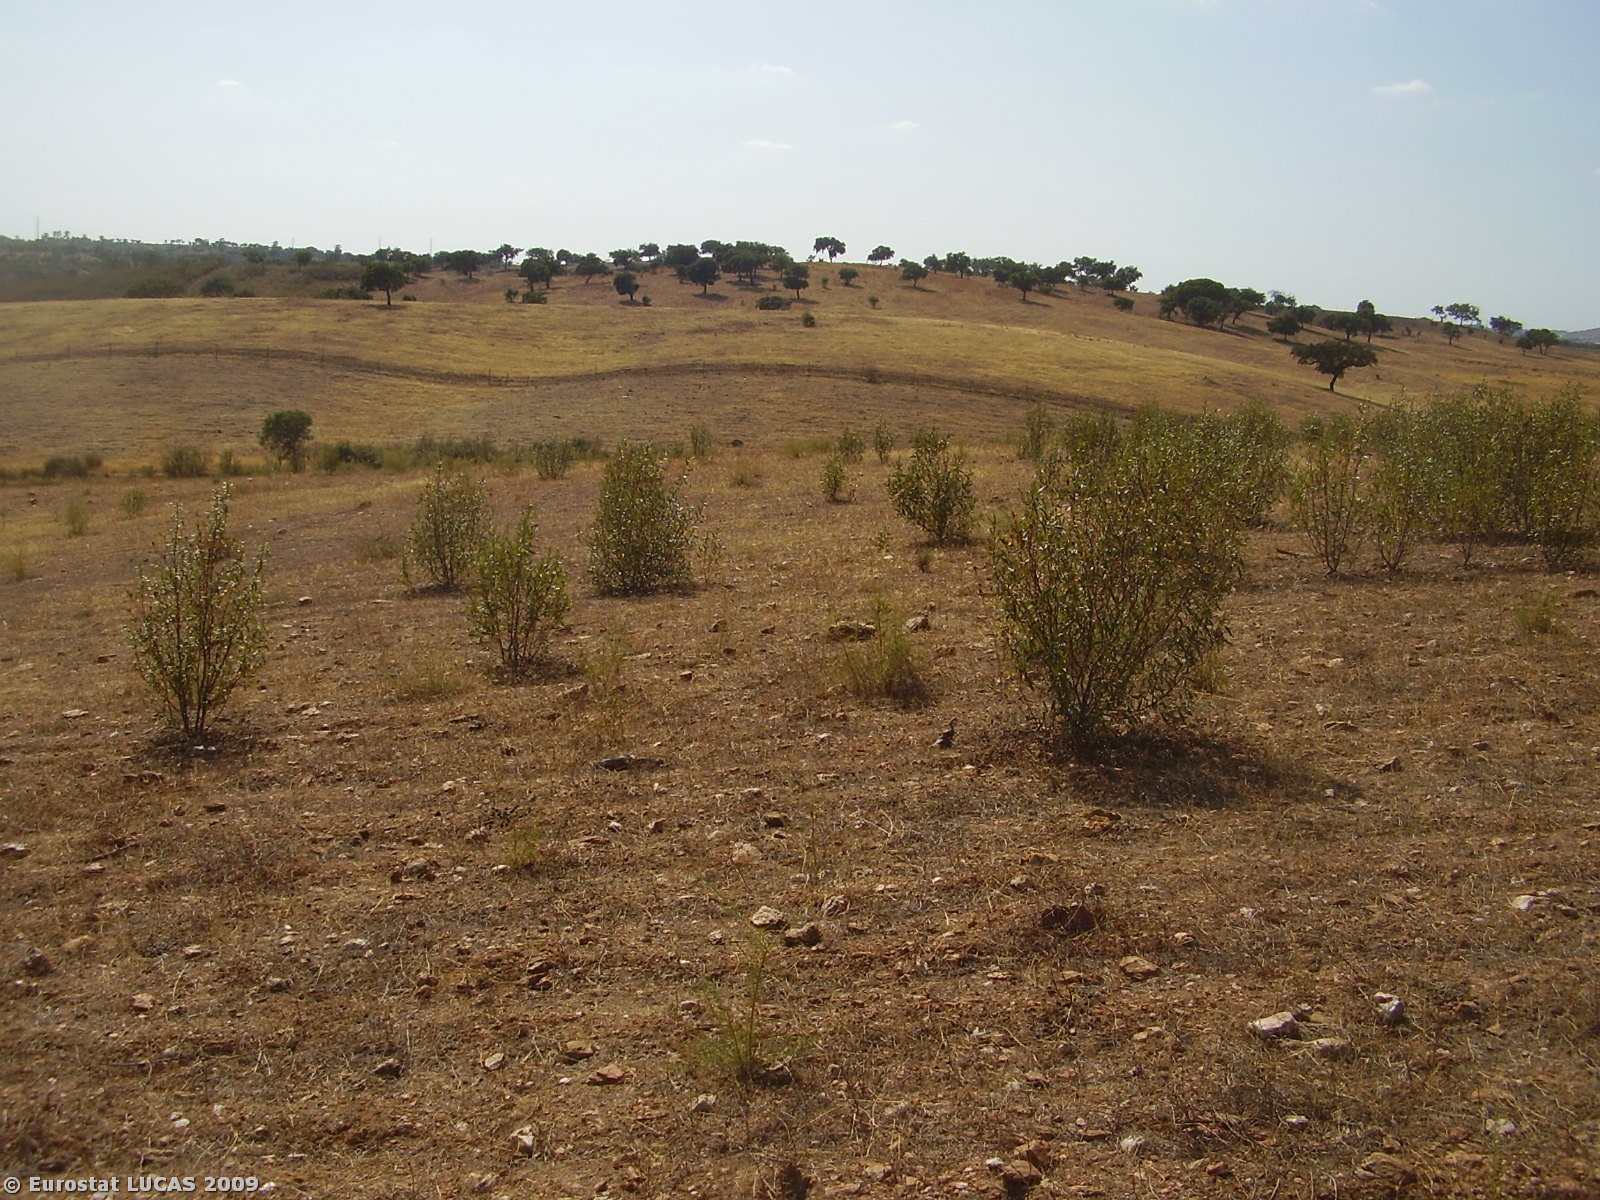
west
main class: Grassland
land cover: Grassland without tree/shrub cover
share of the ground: > 75 %
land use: Fallow land
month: August
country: PT
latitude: 38.2842
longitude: -7.6450
